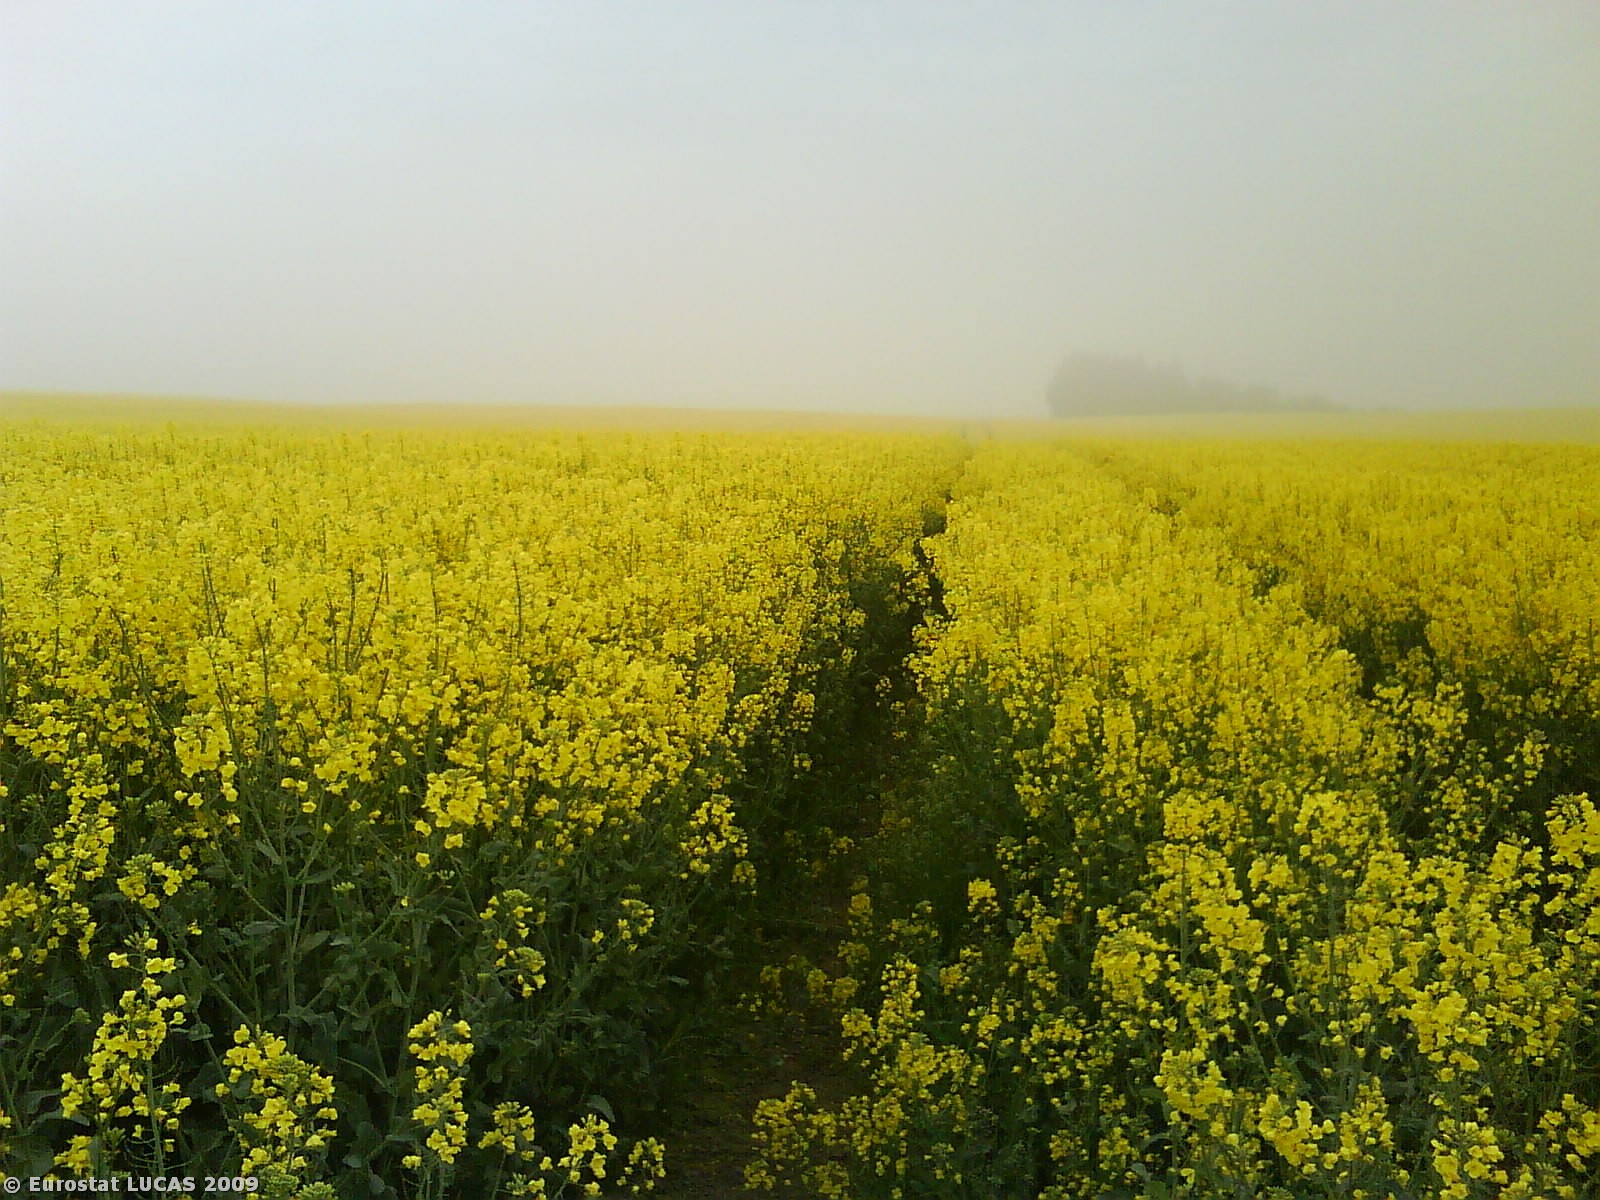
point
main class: Cropland
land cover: Rape and turnip rape
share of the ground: > 75 %
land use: Agriculture (excluding fallow land and kitchen gardens)
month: May
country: DK
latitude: 56.3492
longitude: 10.2747
